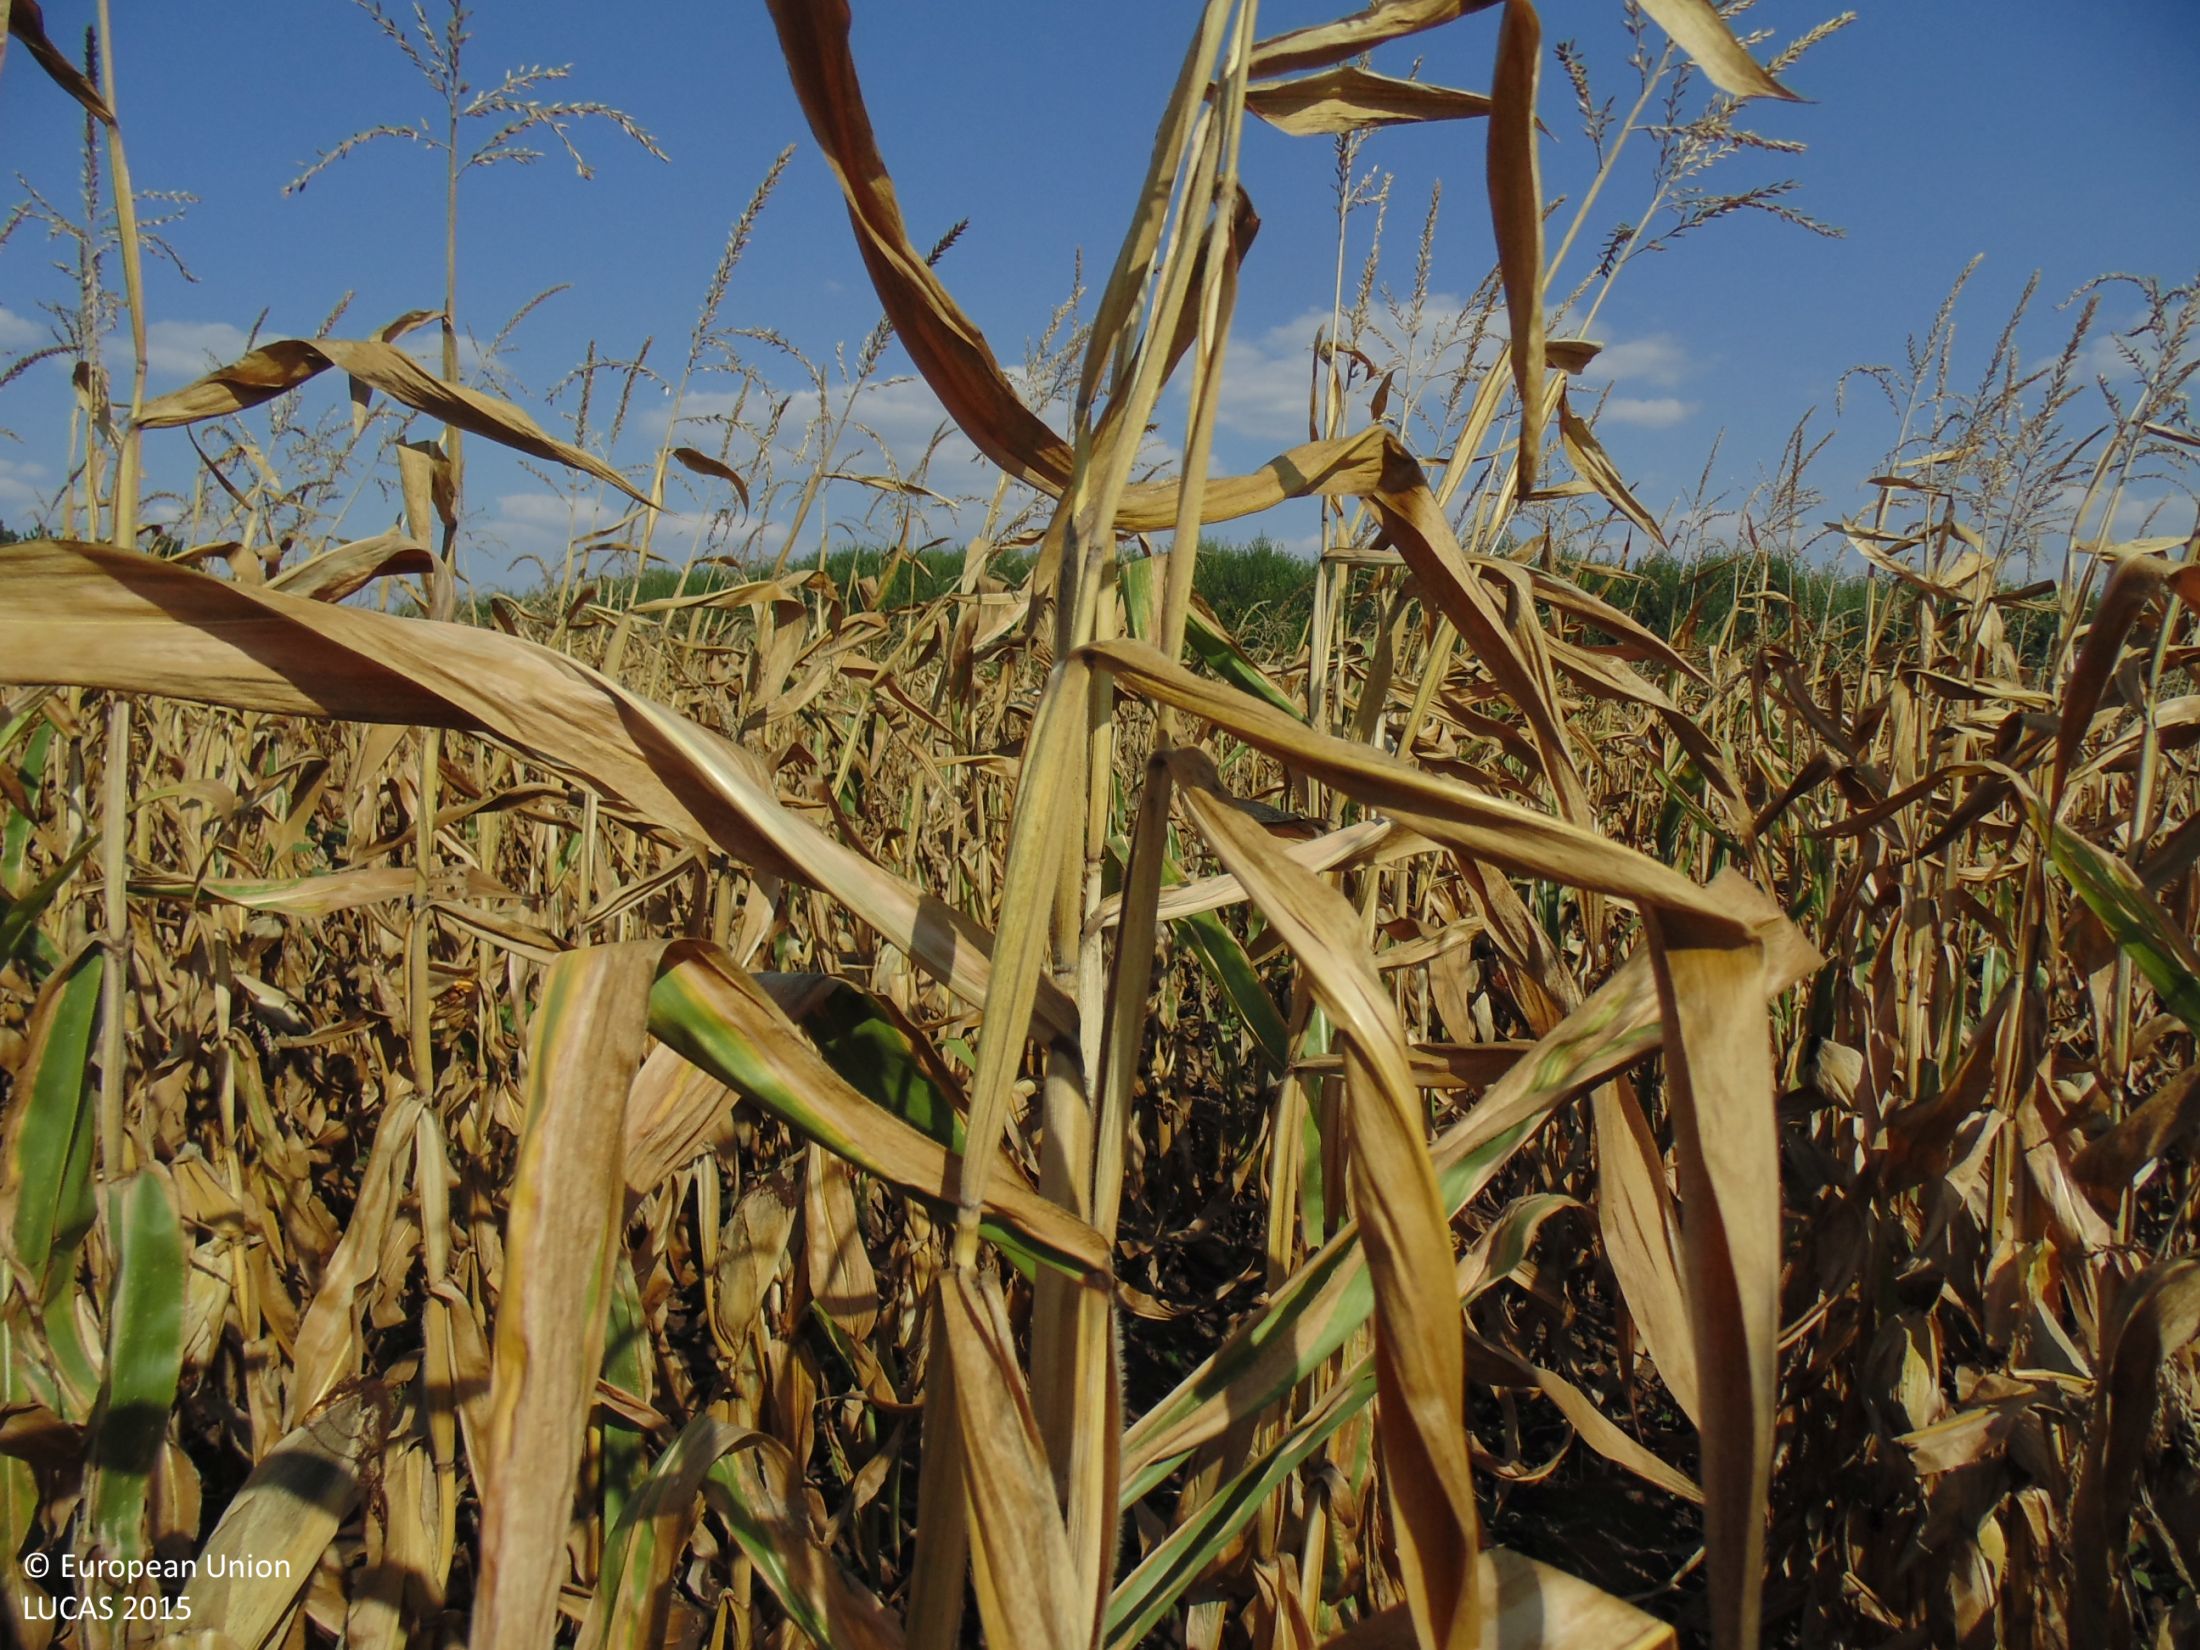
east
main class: Cropland
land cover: Maize
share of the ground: > 75 %
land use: Agriculture (excluding fallow land and kitchen gardens)
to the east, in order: Maize; Spontaneously vegetated surfaces; Tracks; Grassland with sparse tree/shrub cover; Artificial constructions in urban areas
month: August
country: BG
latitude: 43.7046
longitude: 27.2389
